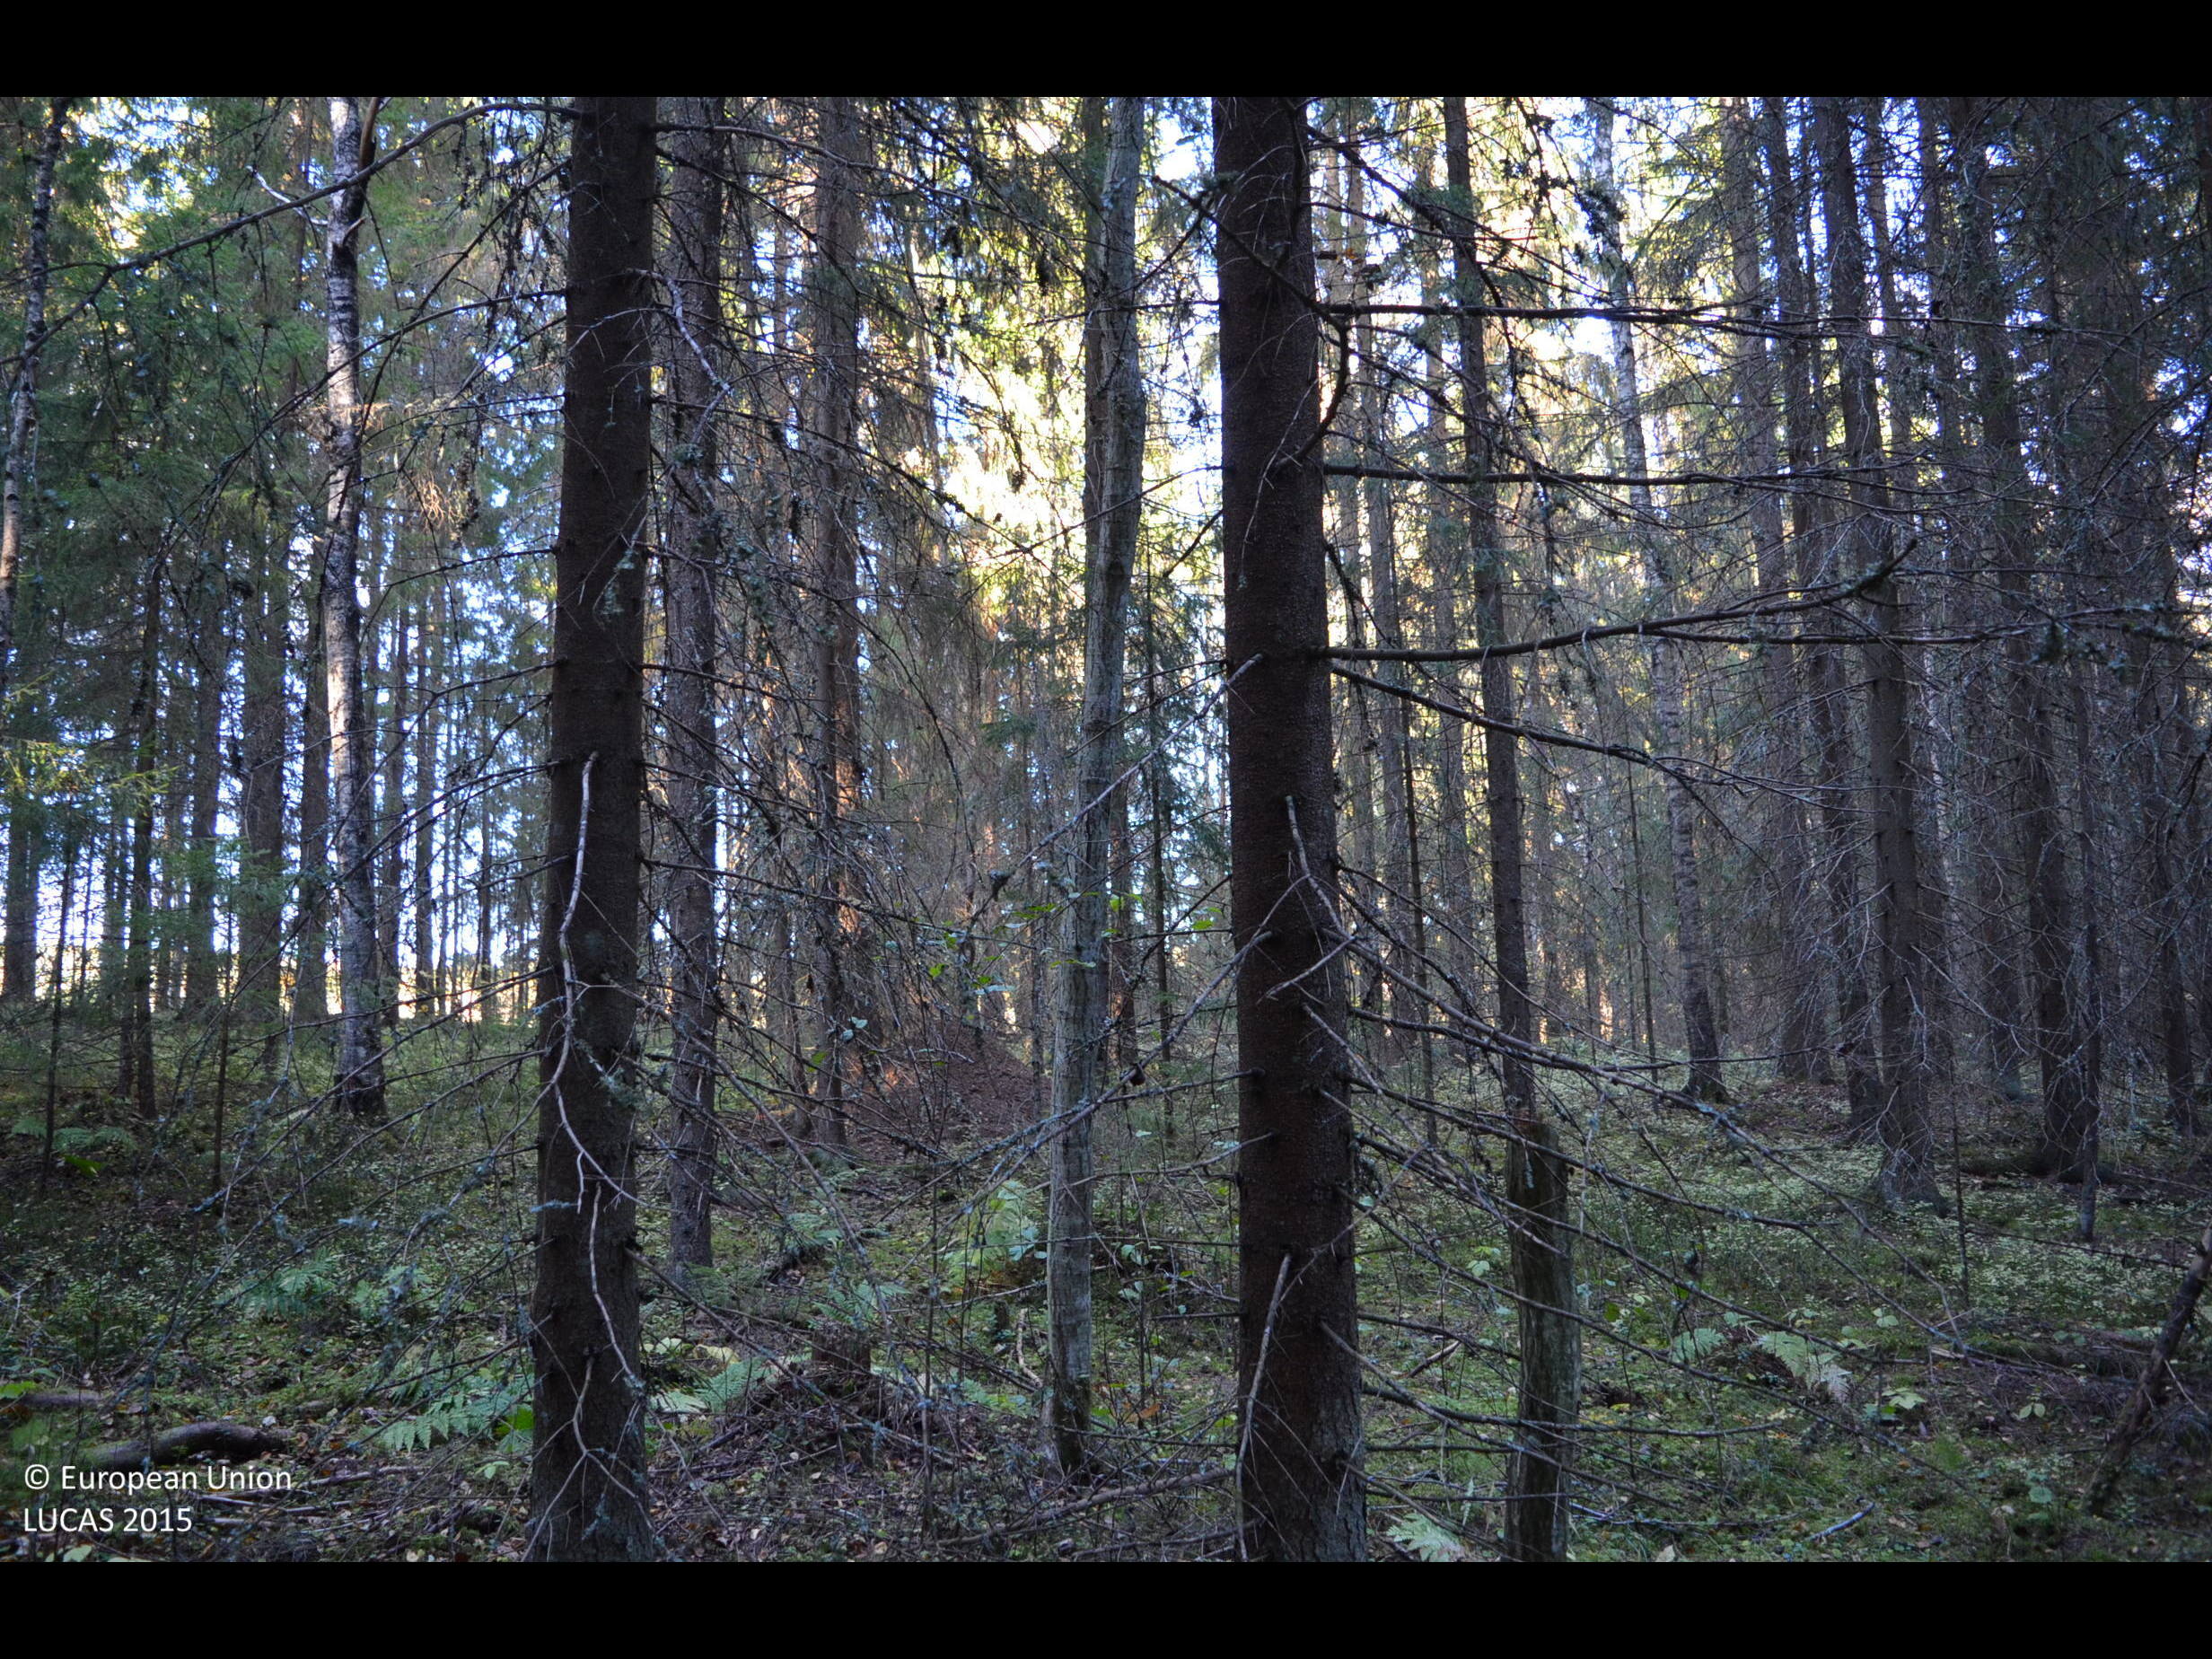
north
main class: Woodland
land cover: Spruce dominated coniferous woodland
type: boreal forest
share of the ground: > 75 %
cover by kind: coniferous forest trees 65 %, broadleaved forest trees 10 %, shrubs 10 %, lichens and mosses 10 %, herbaceous plants 5 %
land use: Forestry
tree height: > 5 m
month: October
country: FI
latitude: 61.5777
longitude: 23.3157
